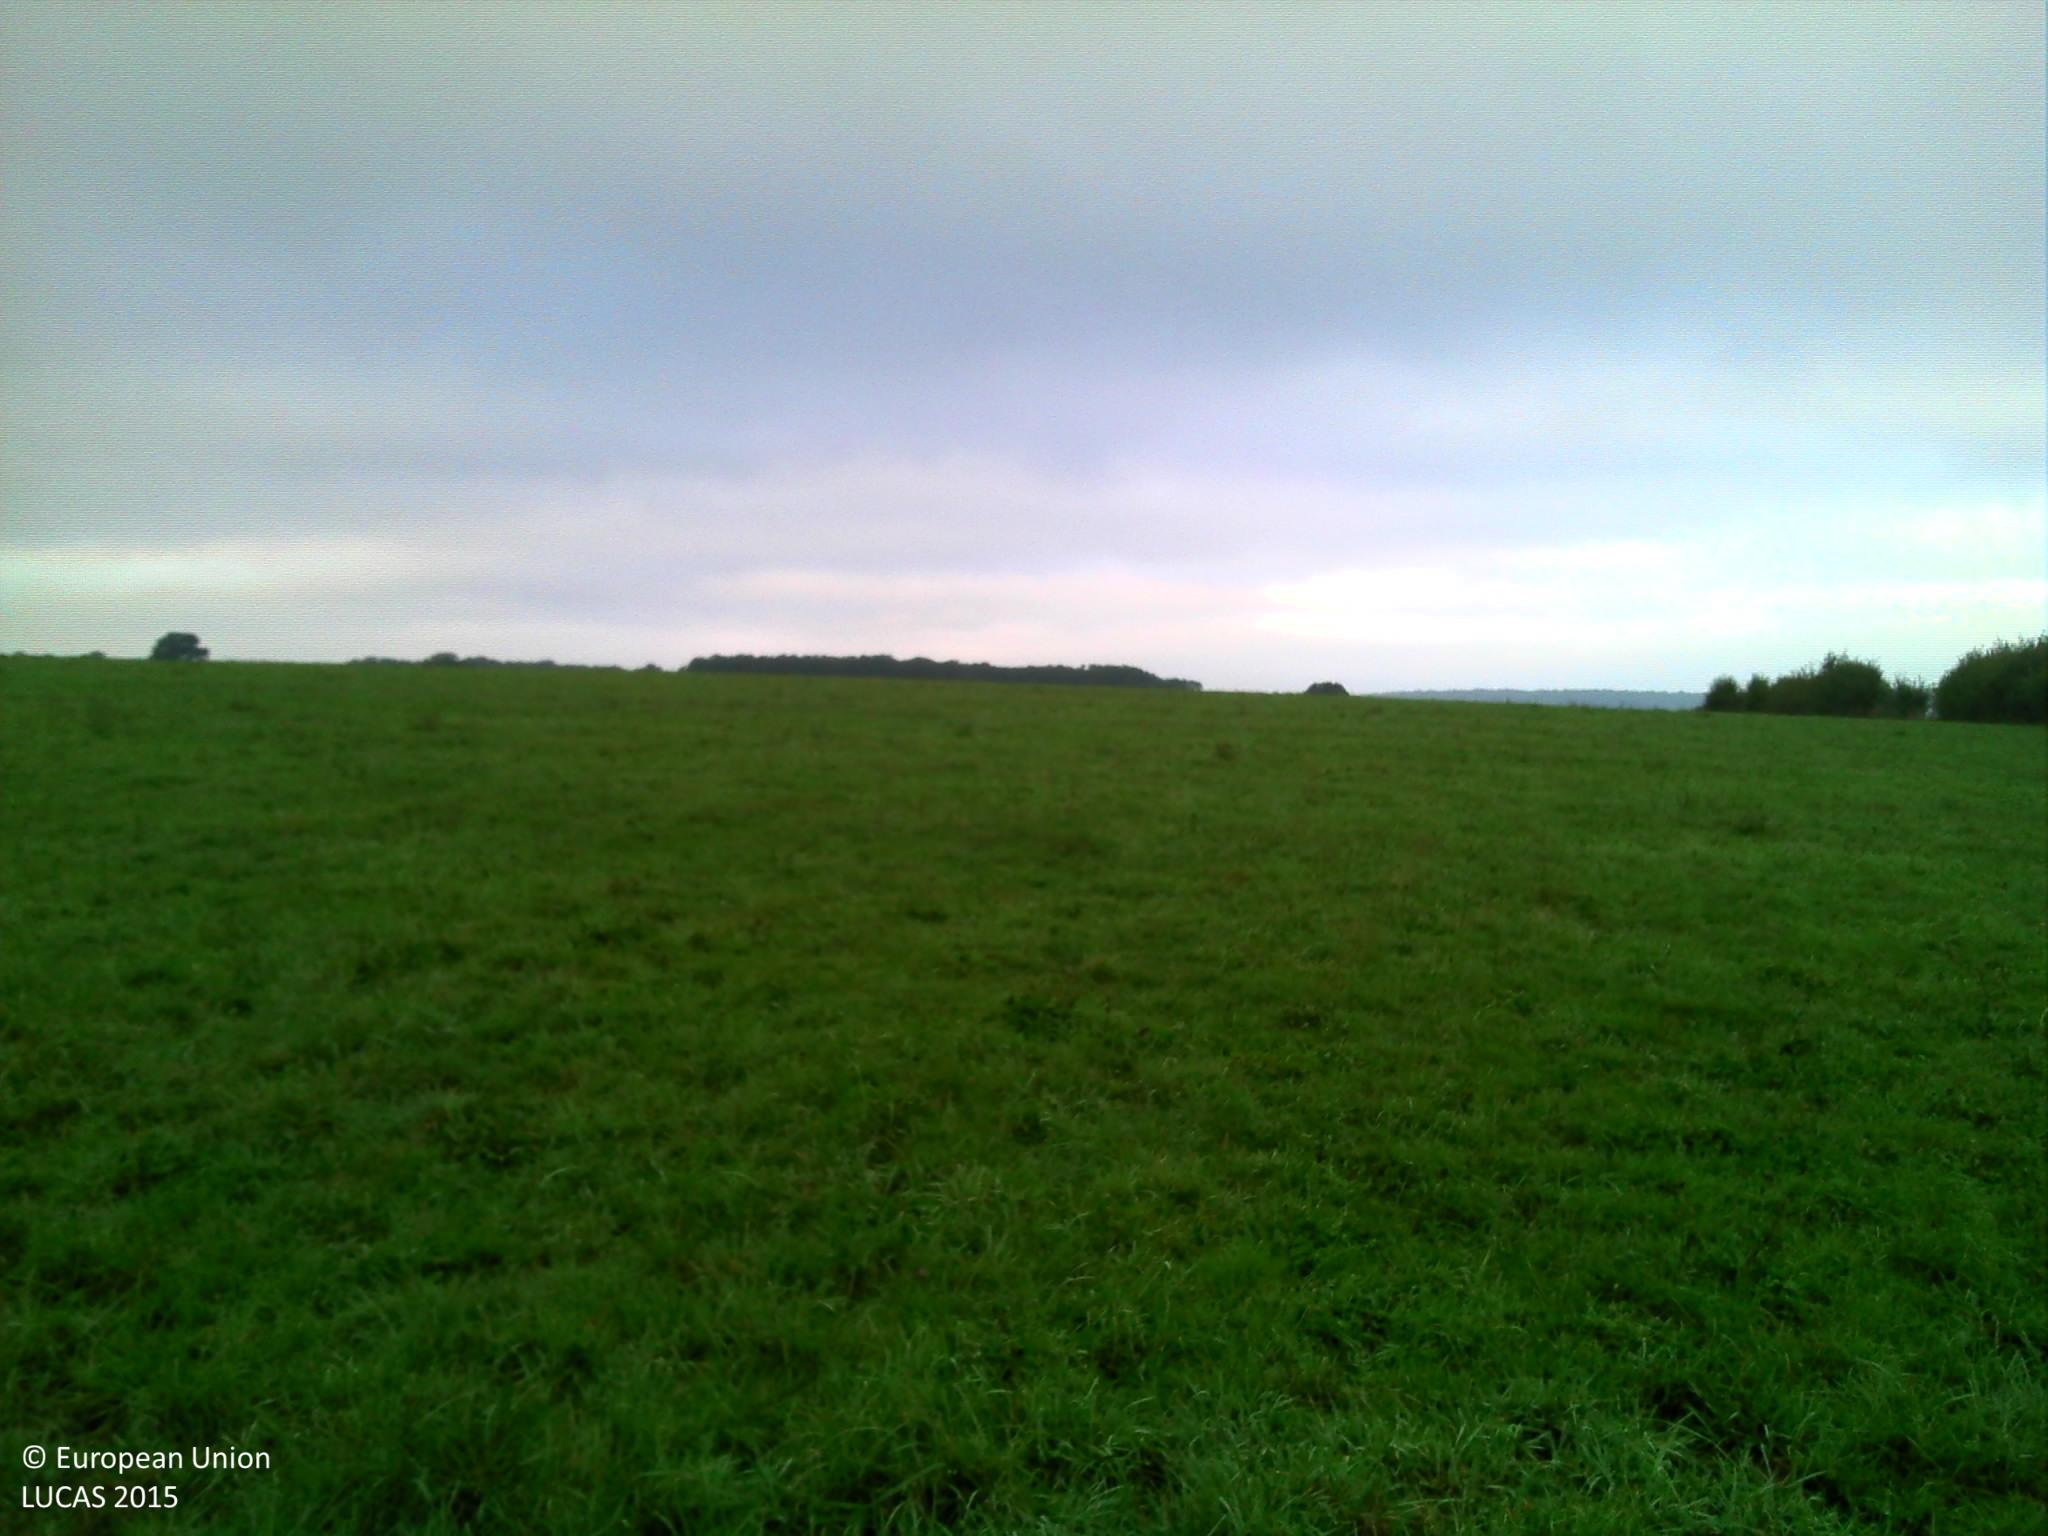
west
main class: Grassland
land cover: Grassland without tree/shrub cover
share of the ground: > 75 %
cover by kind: herbaceous plants 100 %
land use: Agriculture (excluding fallow land and kitchen gardens)
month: September
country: FR
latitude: 47.1290
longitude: 4.4762
